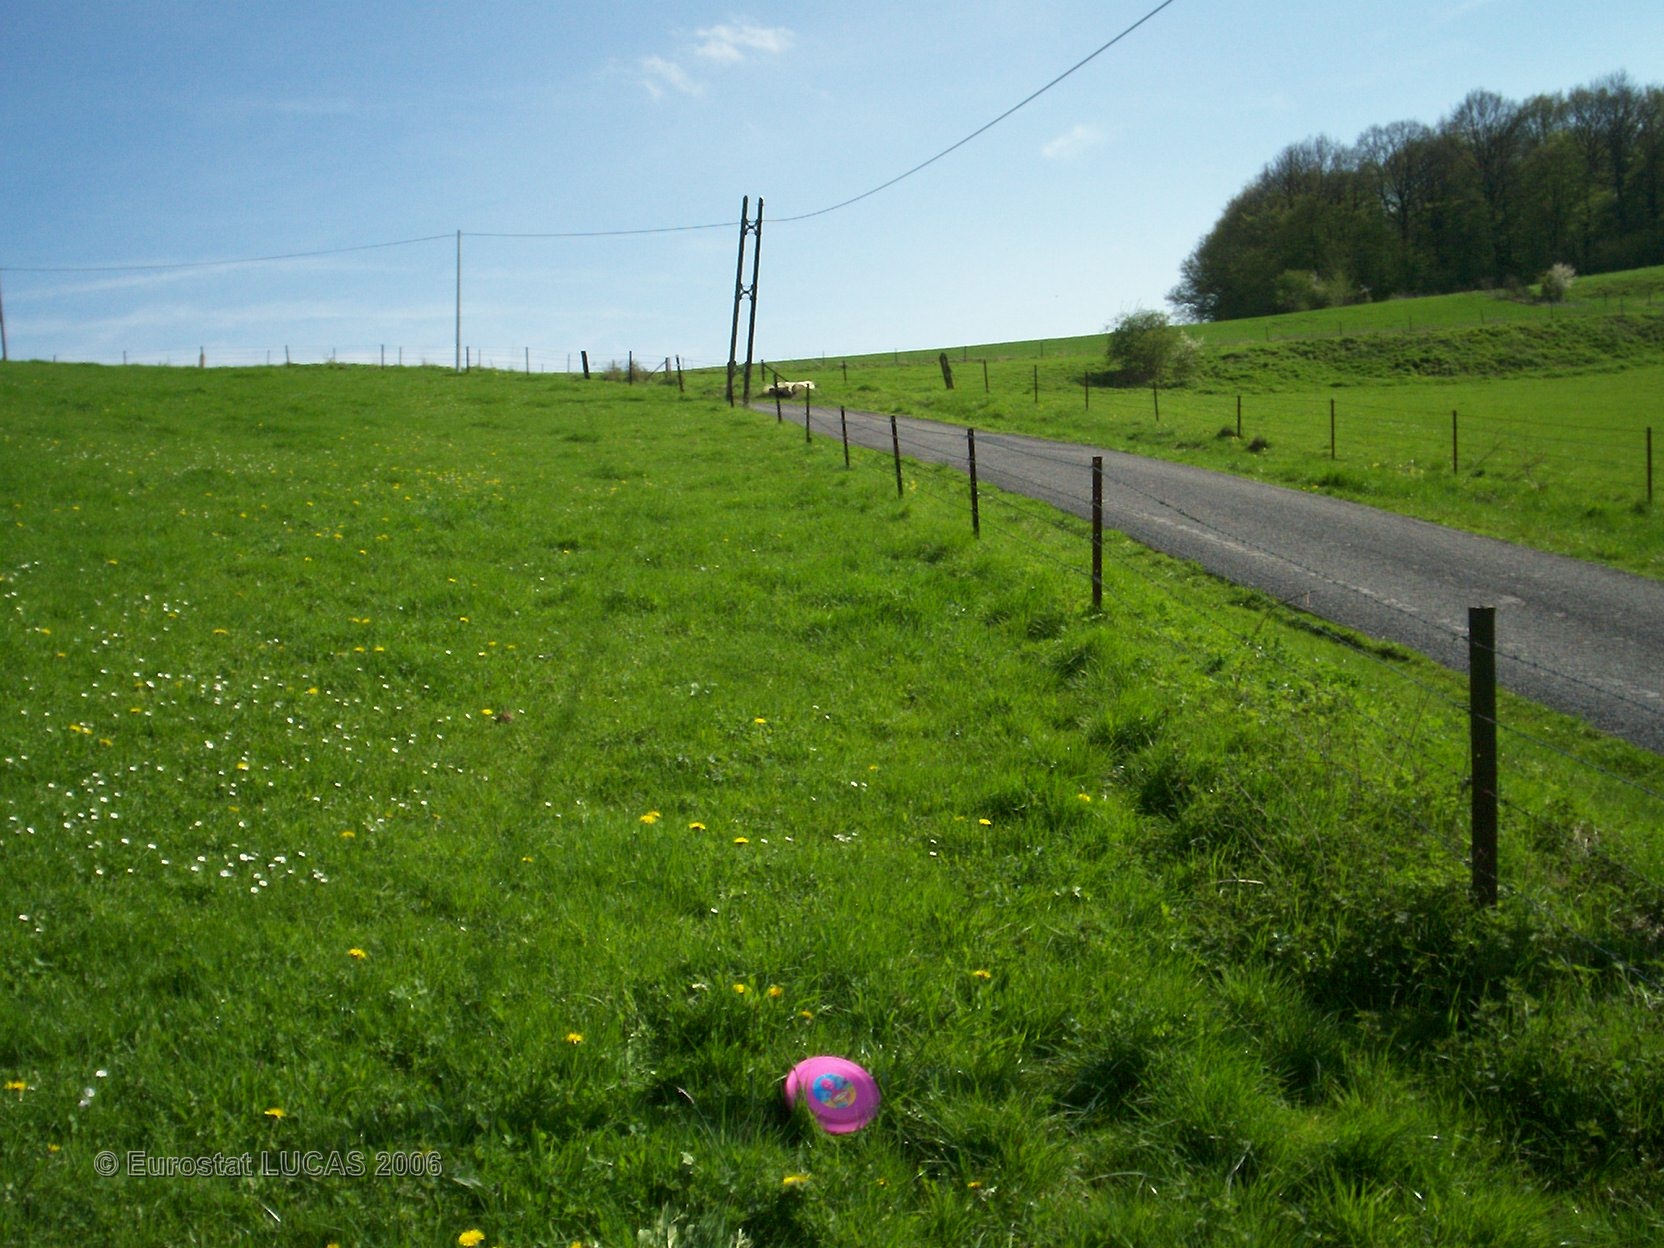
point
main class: Grassland
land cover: Grassland without tree/shrub cover
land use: Agriculture (excluding fallow land and kitchen gardens)
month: May
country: FR
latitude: 49.8079
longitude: 4.3122
